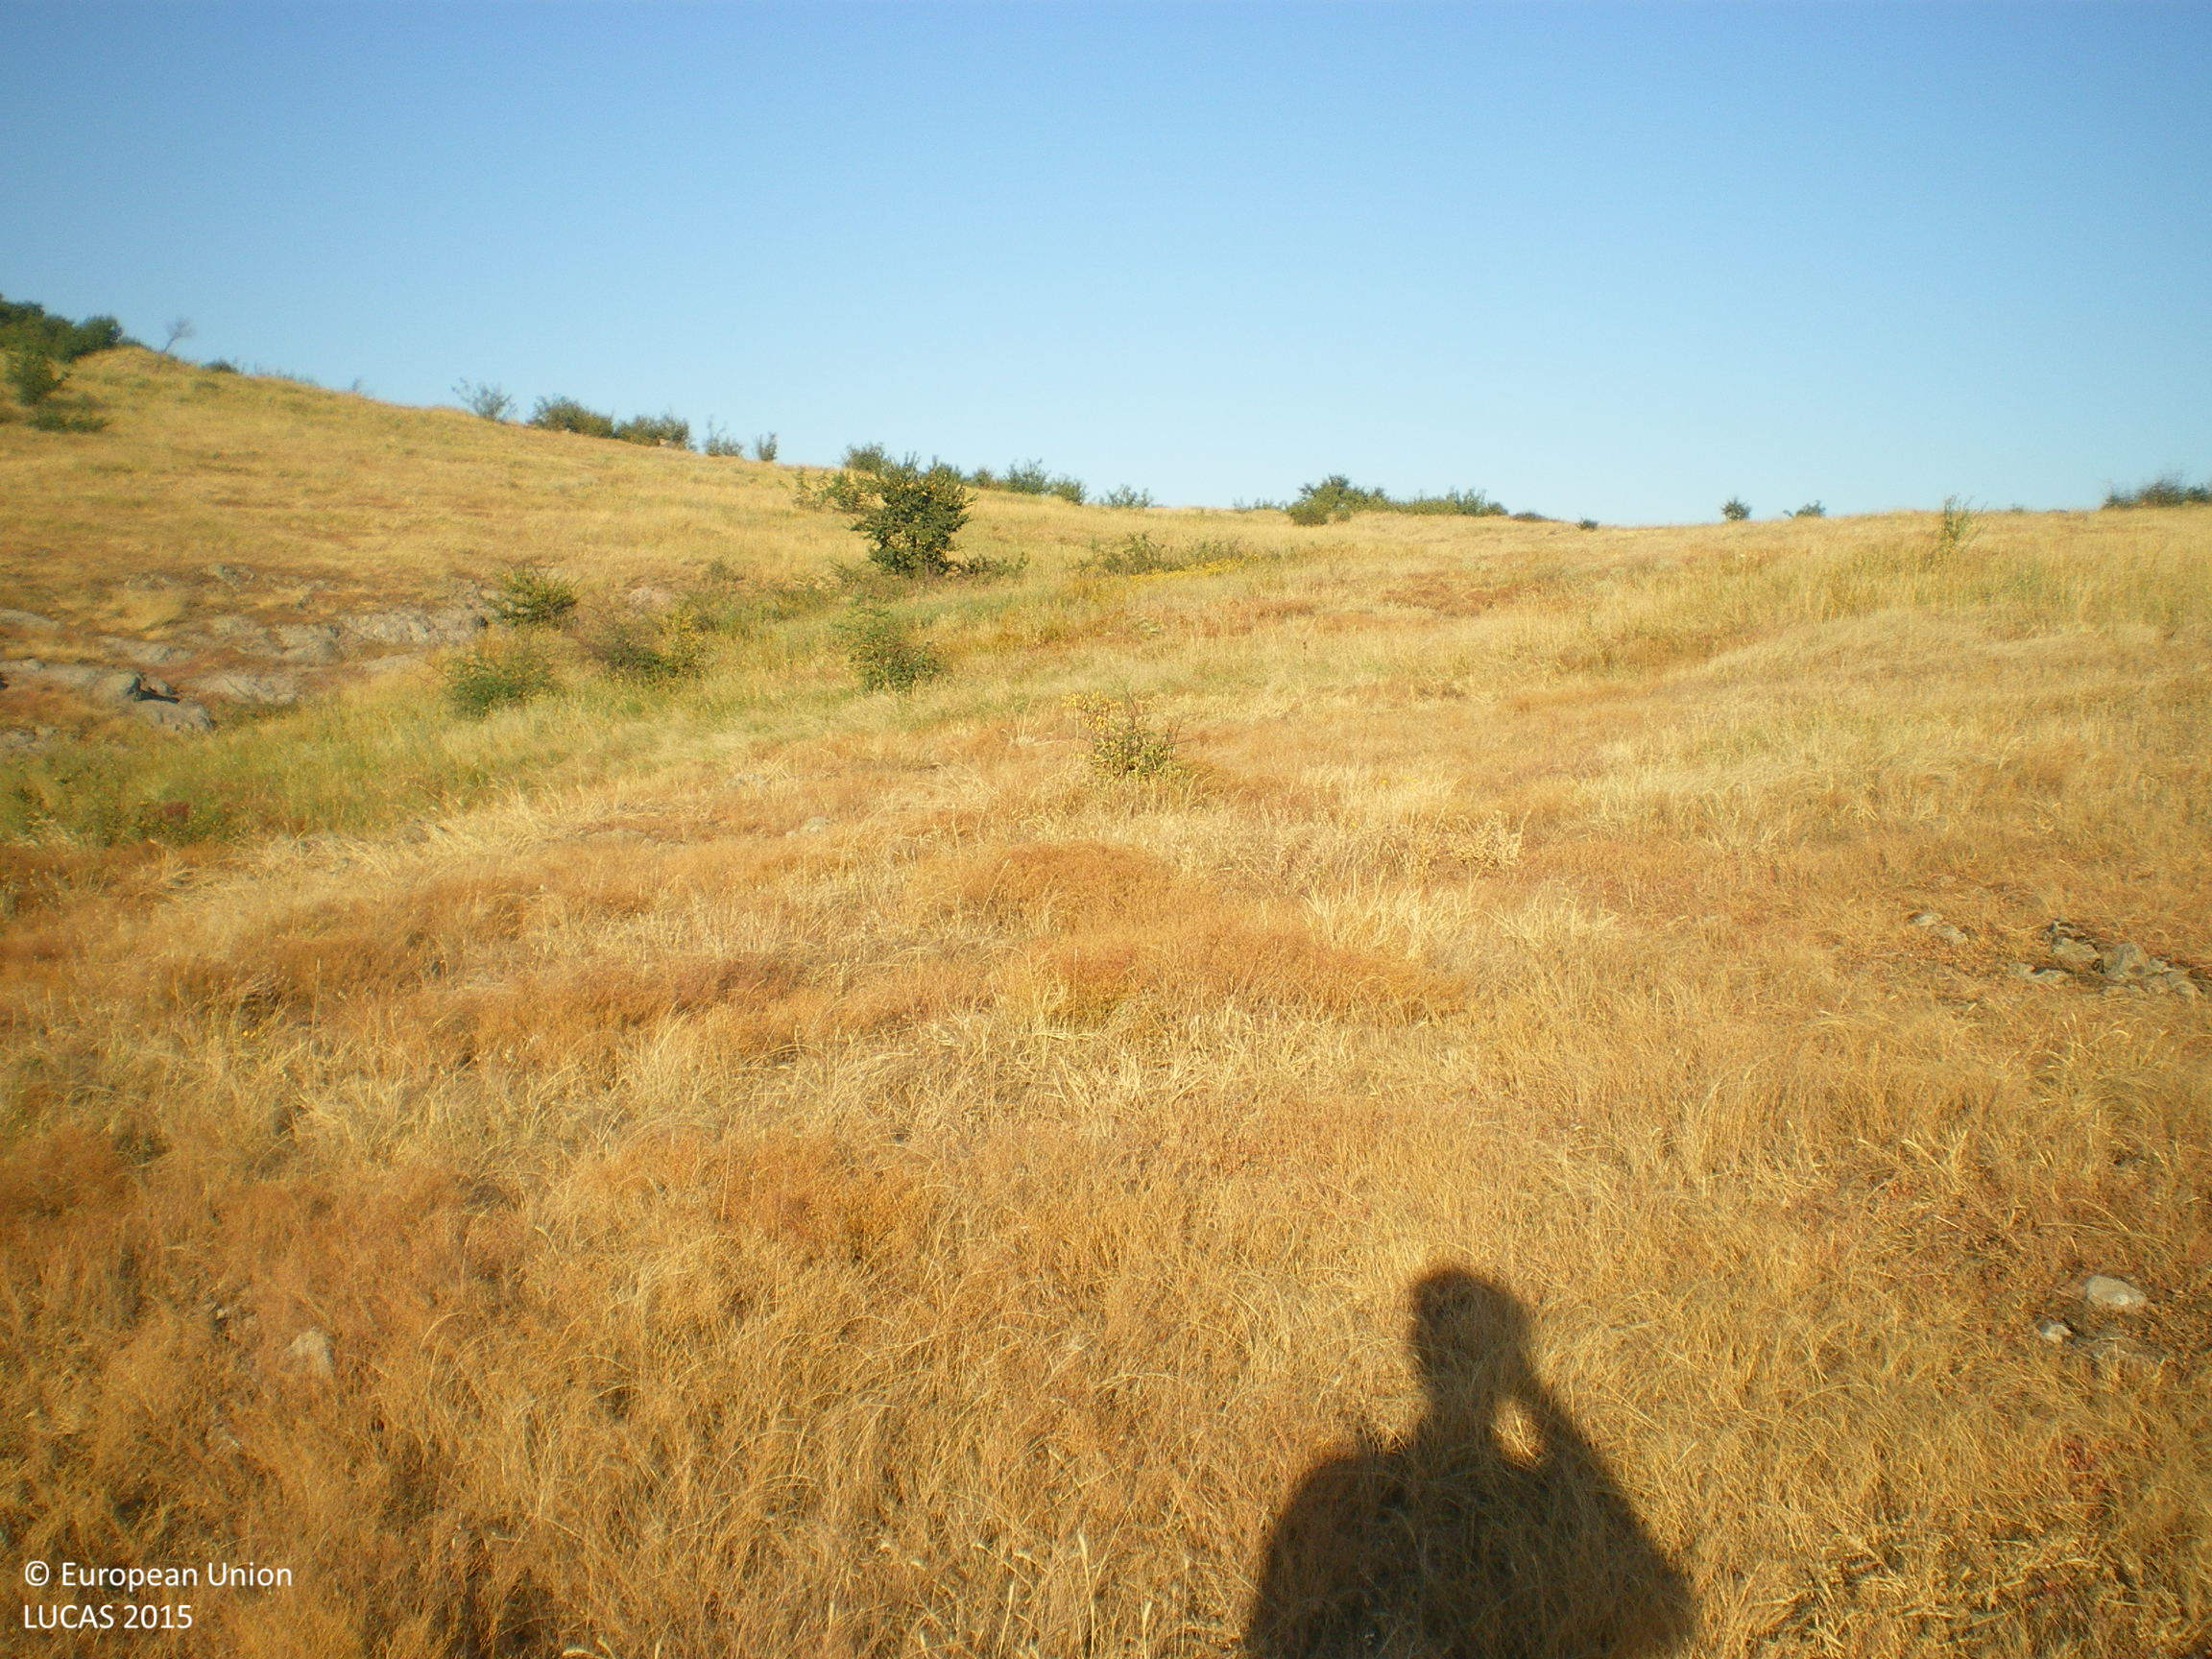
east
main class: Grassland
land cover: Grassland without tree/shrub cover
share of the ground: > 75 %
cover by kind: herbaceous plants 90 %, unconsolidated bare surface 10 %
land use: Agriculture (excluding fallow land and kitchen gardens)
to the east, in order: Grassland without tree/shrub cover; Rocks and stones; Grassland with sparse tree/shrub cover; Grassland without tree/shrub cover; Tracks; Grassland without tree/shrub cover
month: July
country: BG
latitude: 42.0736
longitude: 25.4010
